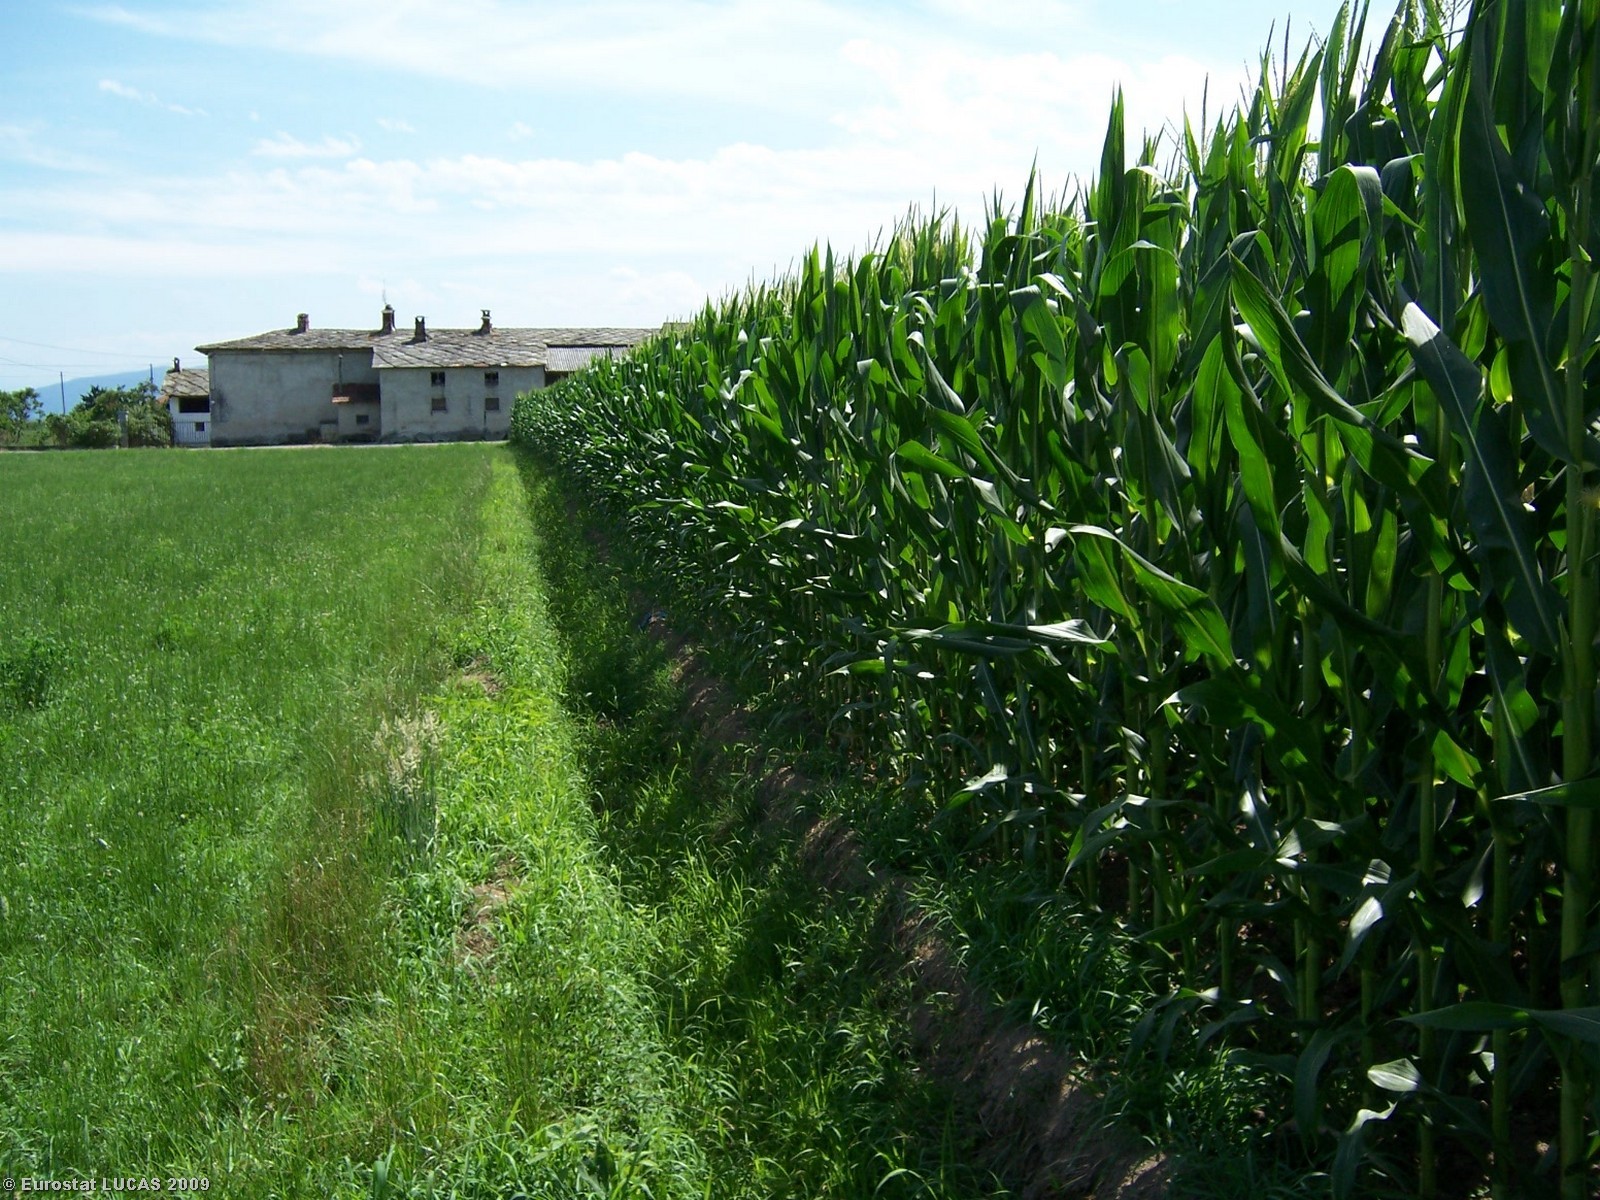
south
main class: Cropland
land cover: Maize
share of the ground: > 75 %
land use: Agriculture (excluding fallow land and kitchen gardens)
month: July
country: IT
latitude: 44.8048
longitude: 7.3877
